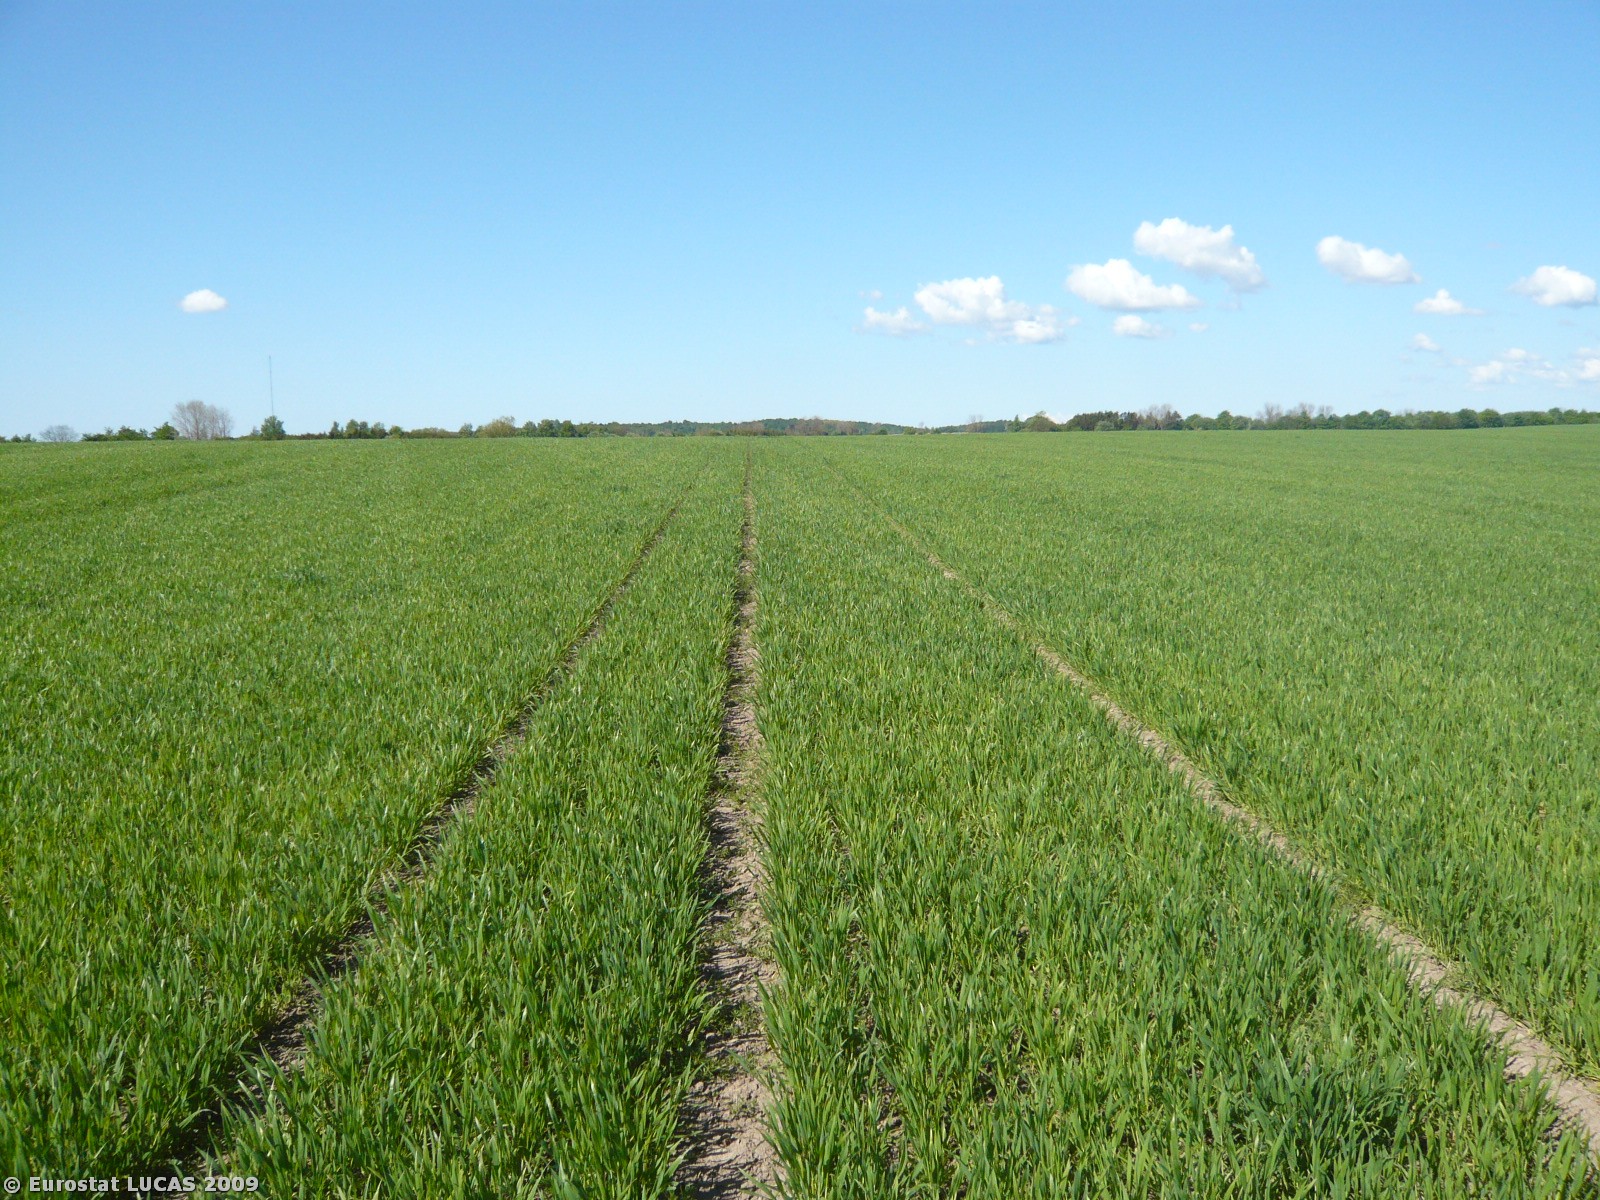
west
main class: Cropland
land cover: Common wheat
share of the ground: > 75 %
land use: Agriculture (excluding fallow land and kitchen gardens)
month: May
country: DK
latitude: 55.0746
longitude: 12.0503
